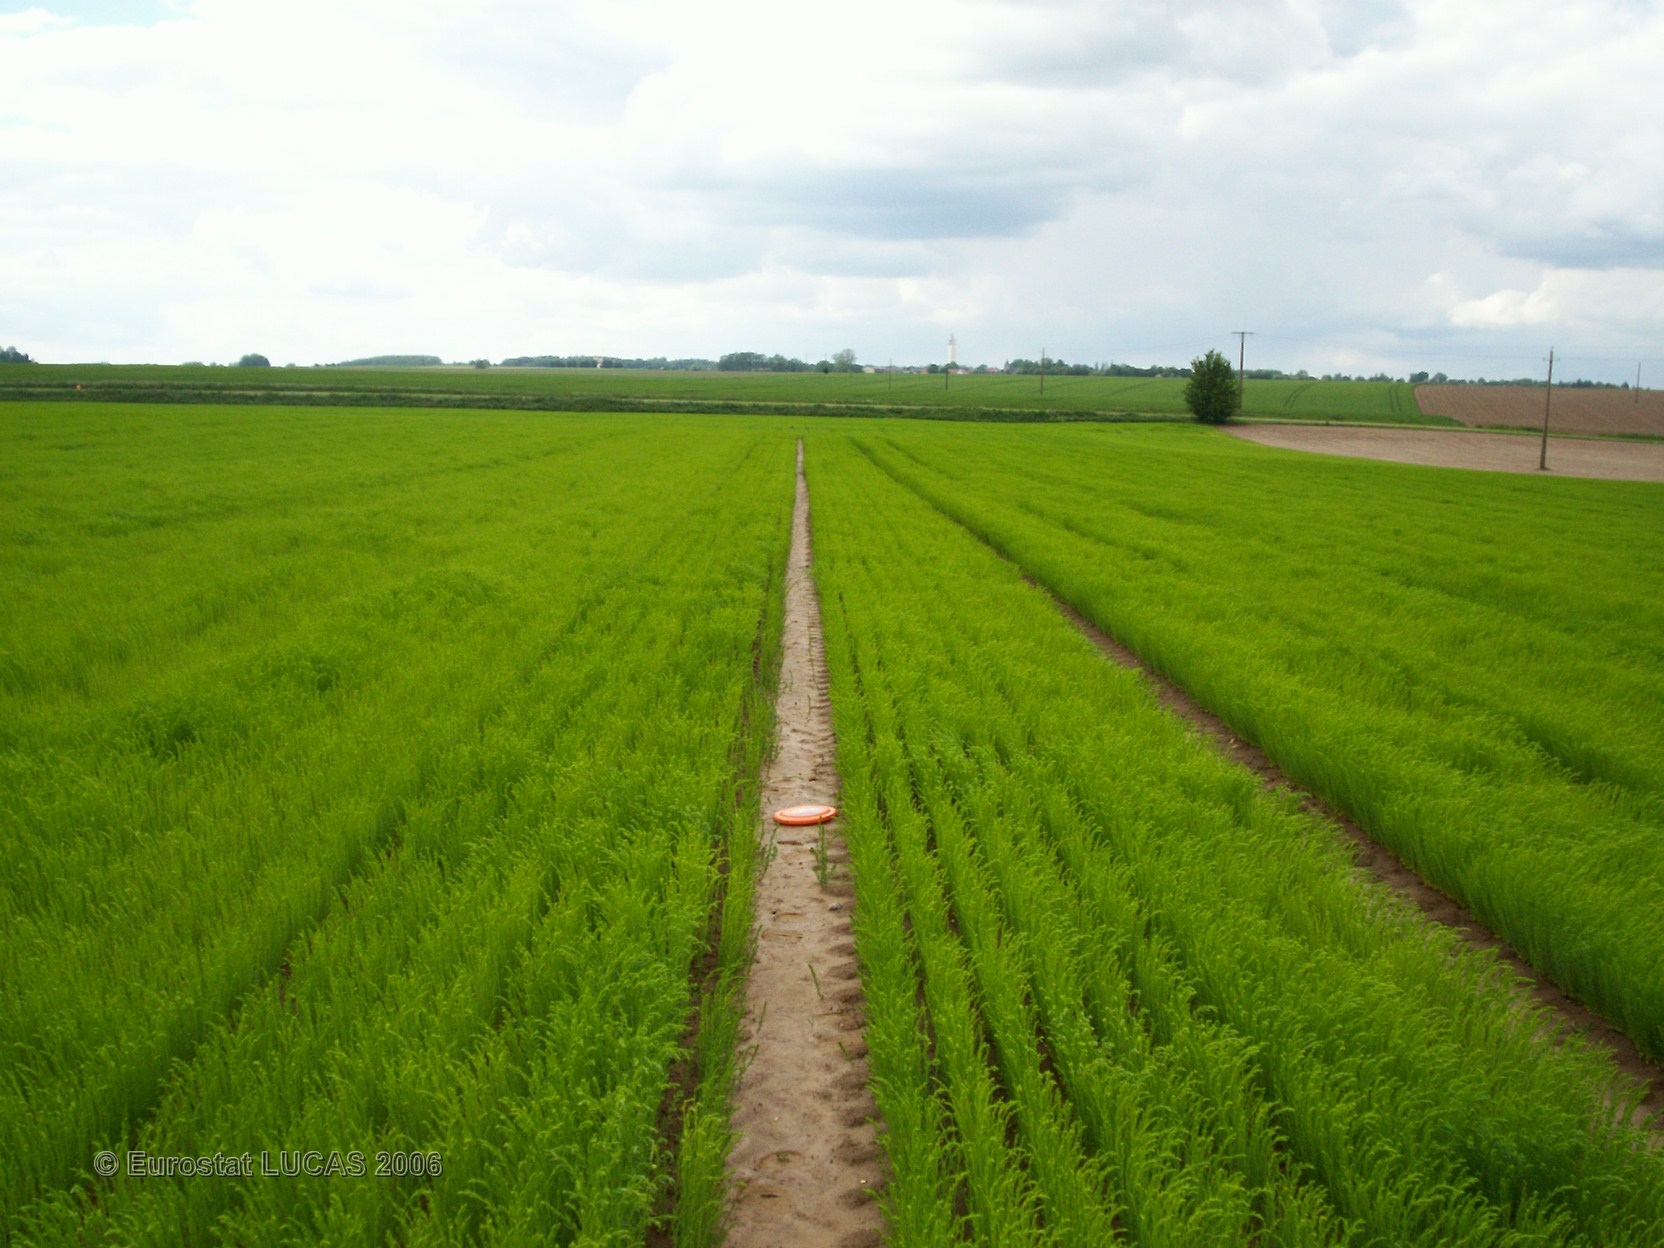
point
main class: Cropland
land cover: Other fibre and oleaginous crops
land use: Agriculture (excluding fallow land and kitchen gardens)
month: May
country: FR
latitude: 50.1950
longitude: 2.5777
